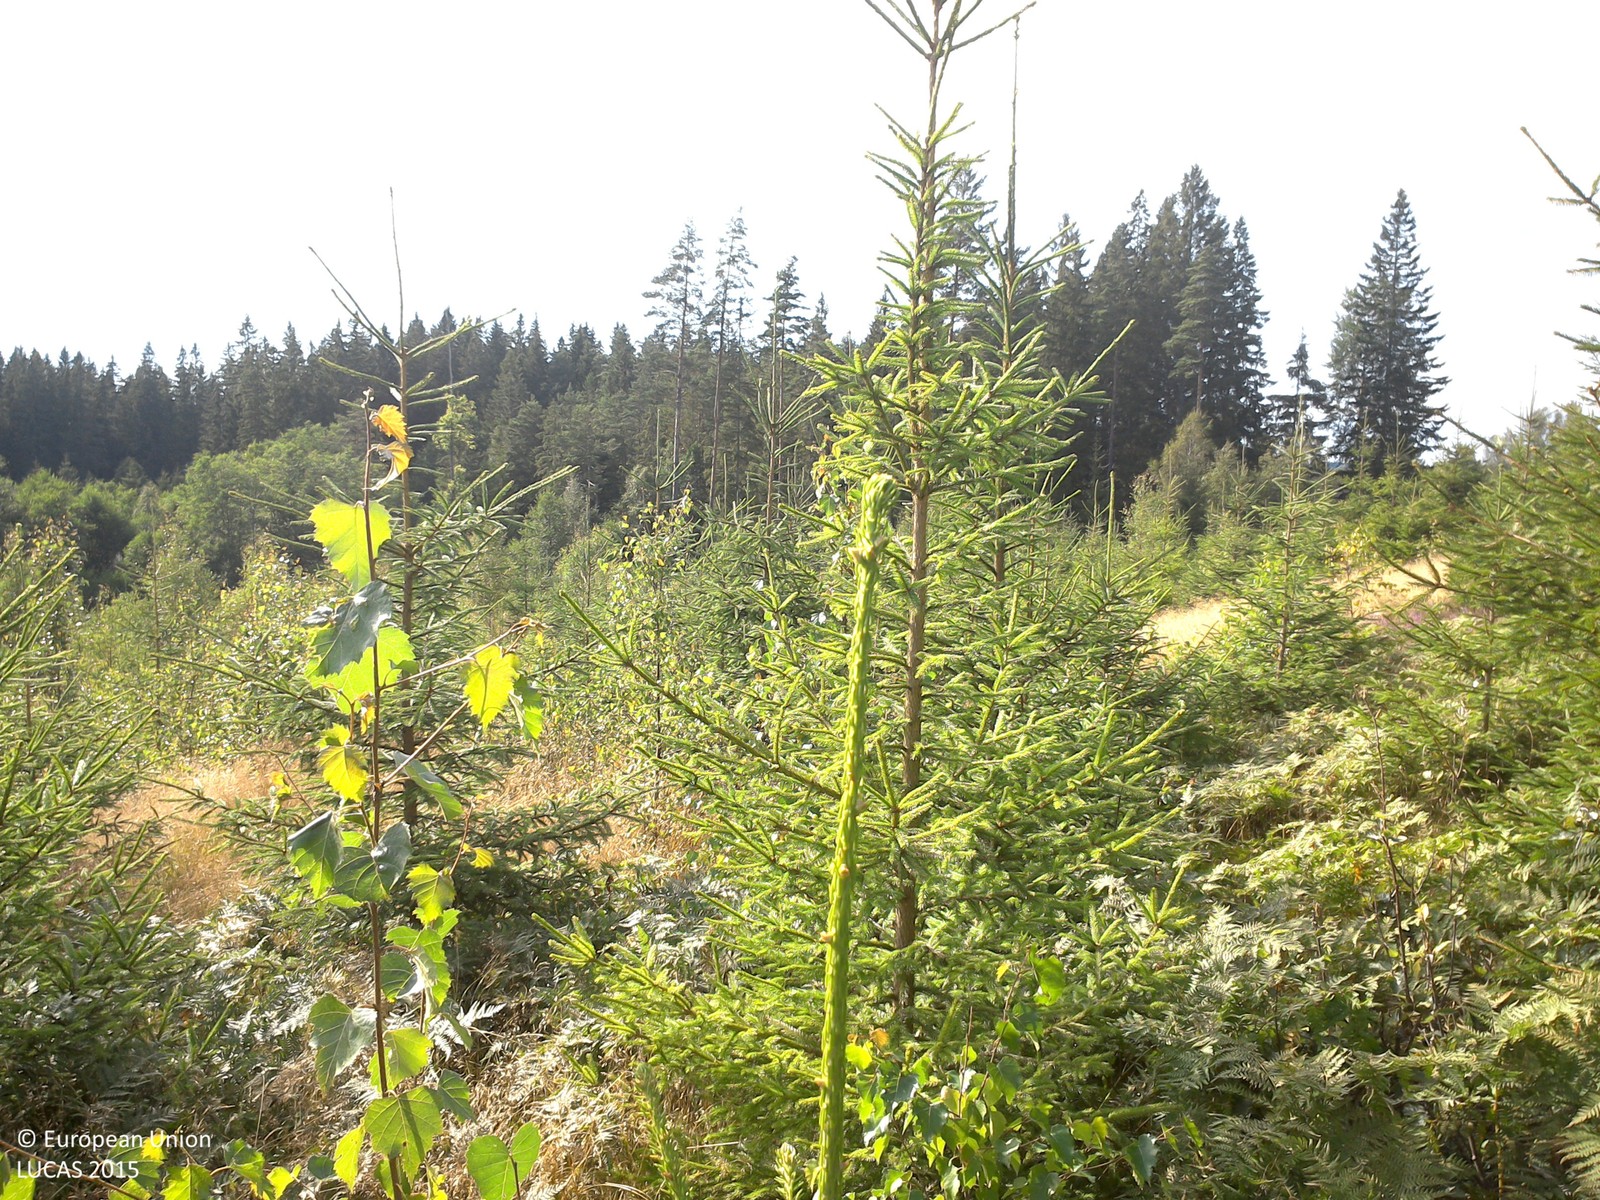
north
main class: Woodland
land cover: Spruce dominated mixed woodland
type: boreal forest
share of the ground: 25 - 50 %
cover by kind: herbaceous plants 70 %, coniferous forest trees 20 %, broadleaved forest trees 10 %
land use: Forestry
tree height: < 5 m
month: August
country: SE
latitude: 57.8664
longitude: 15.2041
